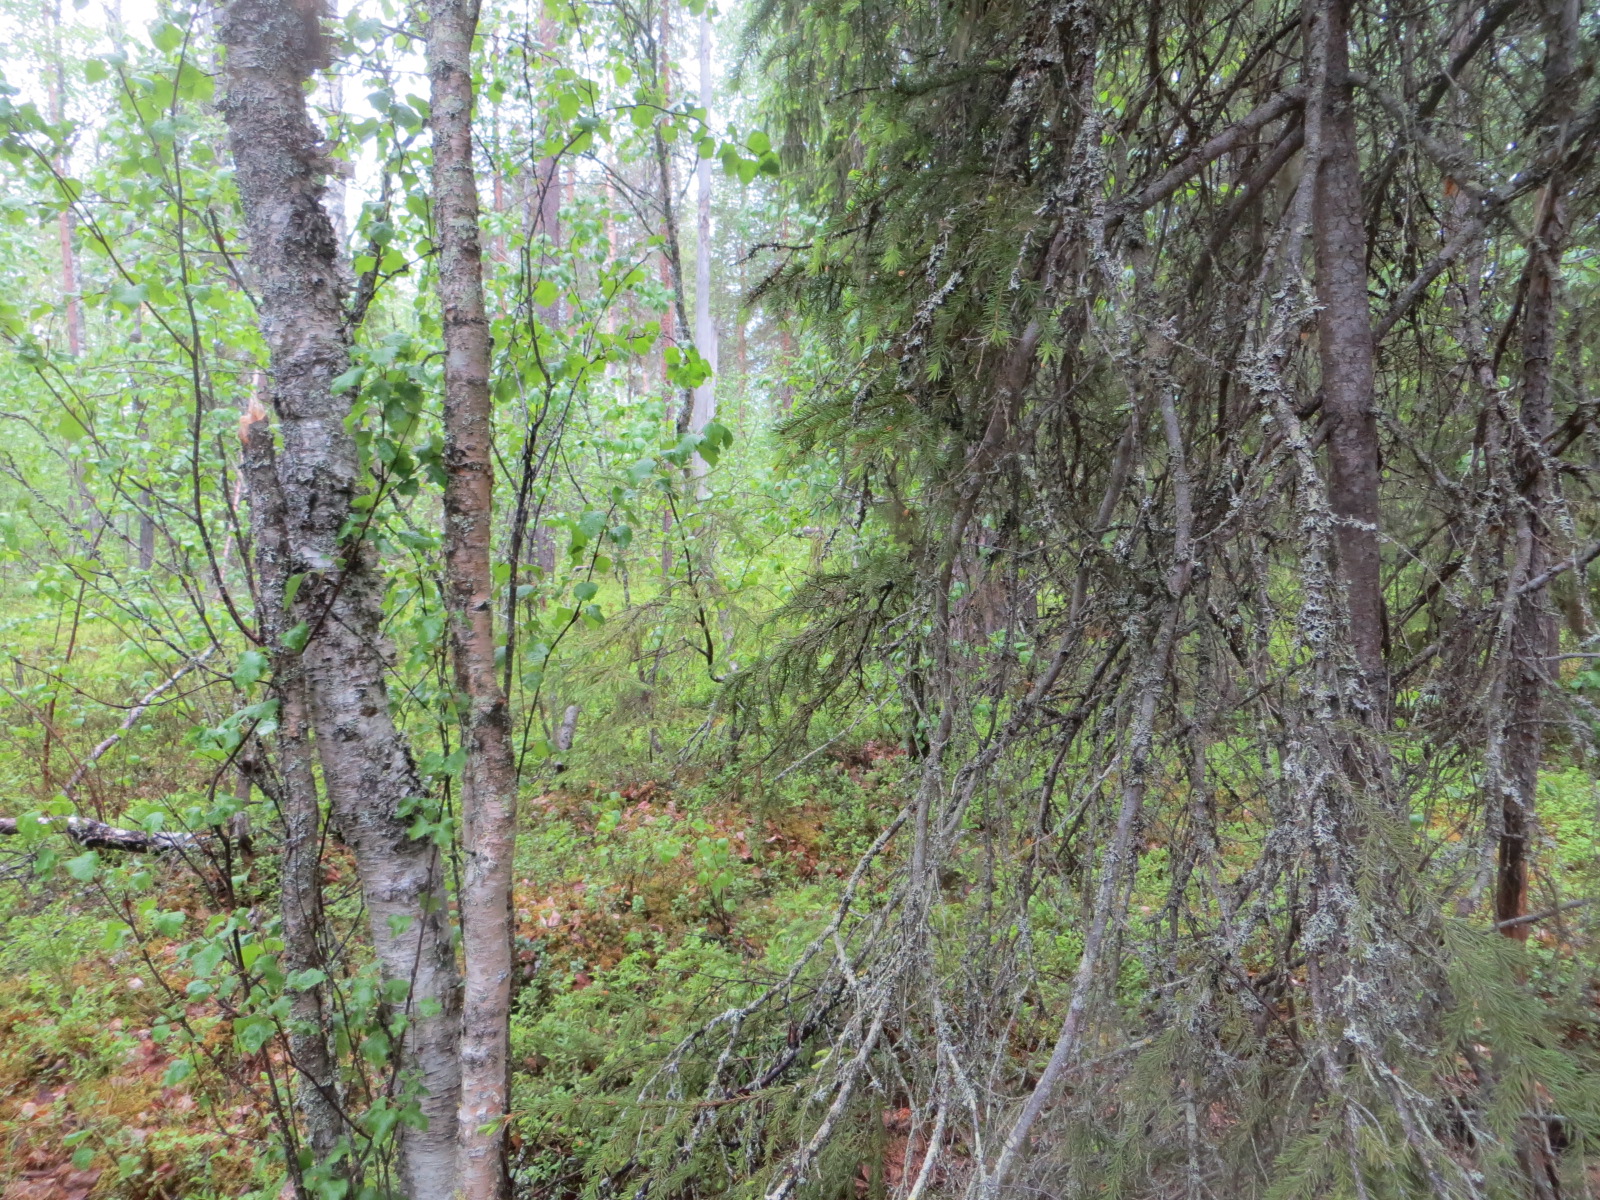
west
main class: Woodland
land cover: Spruce dominated mixed woodland
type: boreal forest
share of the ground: > 75 %
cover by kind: coniferous forest trees 55 %, broadleaved forest trees 25 %, shrubs 10 %, herbaceous plants 10 %
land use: Forestry
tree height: > 5 m
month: June
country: FI
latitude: 66.6380
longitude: 24.9897
